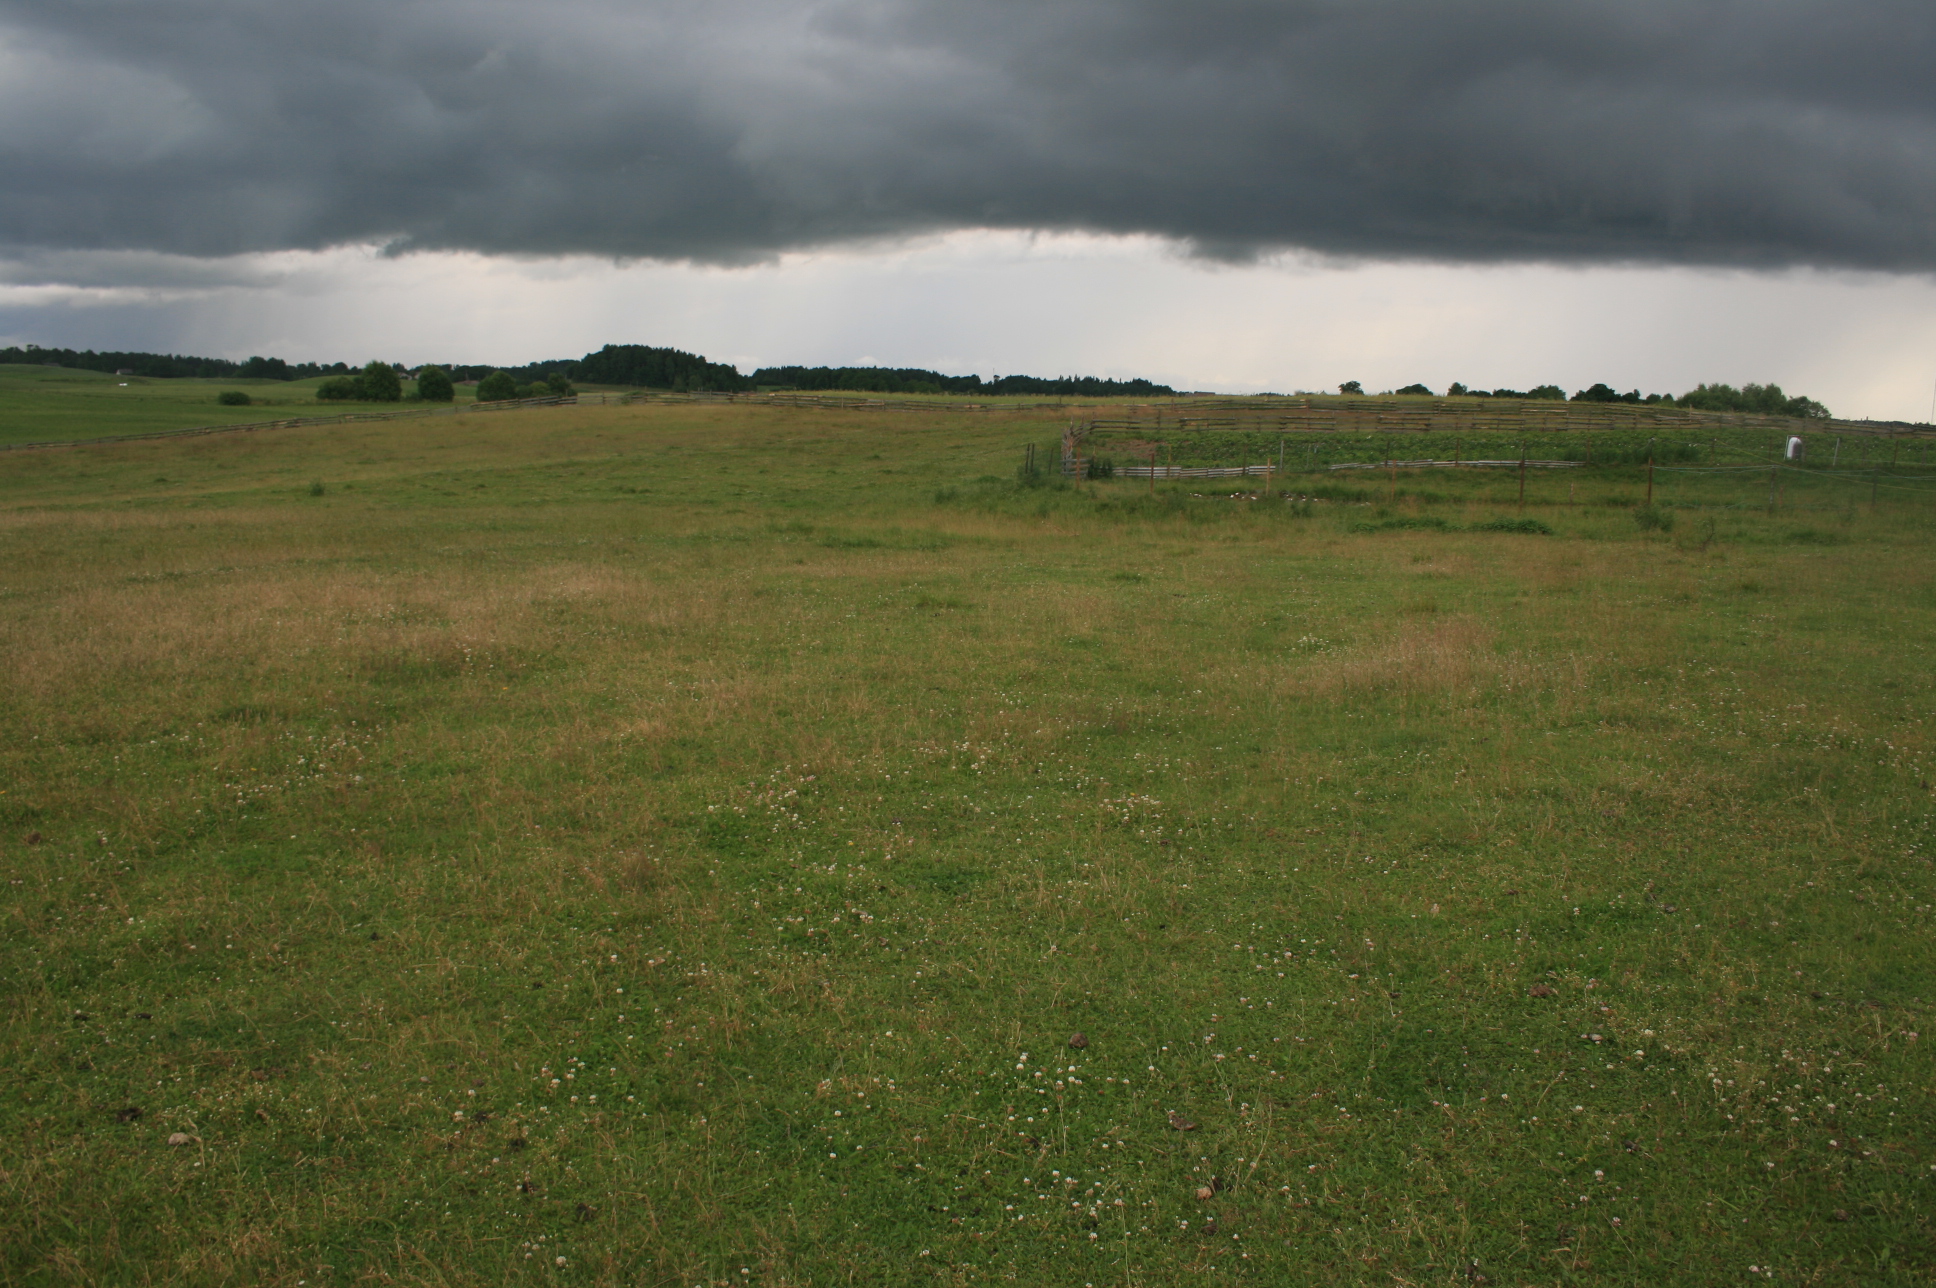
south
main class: Grassland
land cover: Grassland without tree/shrub cover
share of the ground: > 75 %
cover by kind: herbaceous plants 100 %
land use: Agriculture (excluding fallow land and kitchen gardens)
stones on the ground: < 10 %
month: July
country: LT
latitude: 56.0929
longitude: 22.0261
